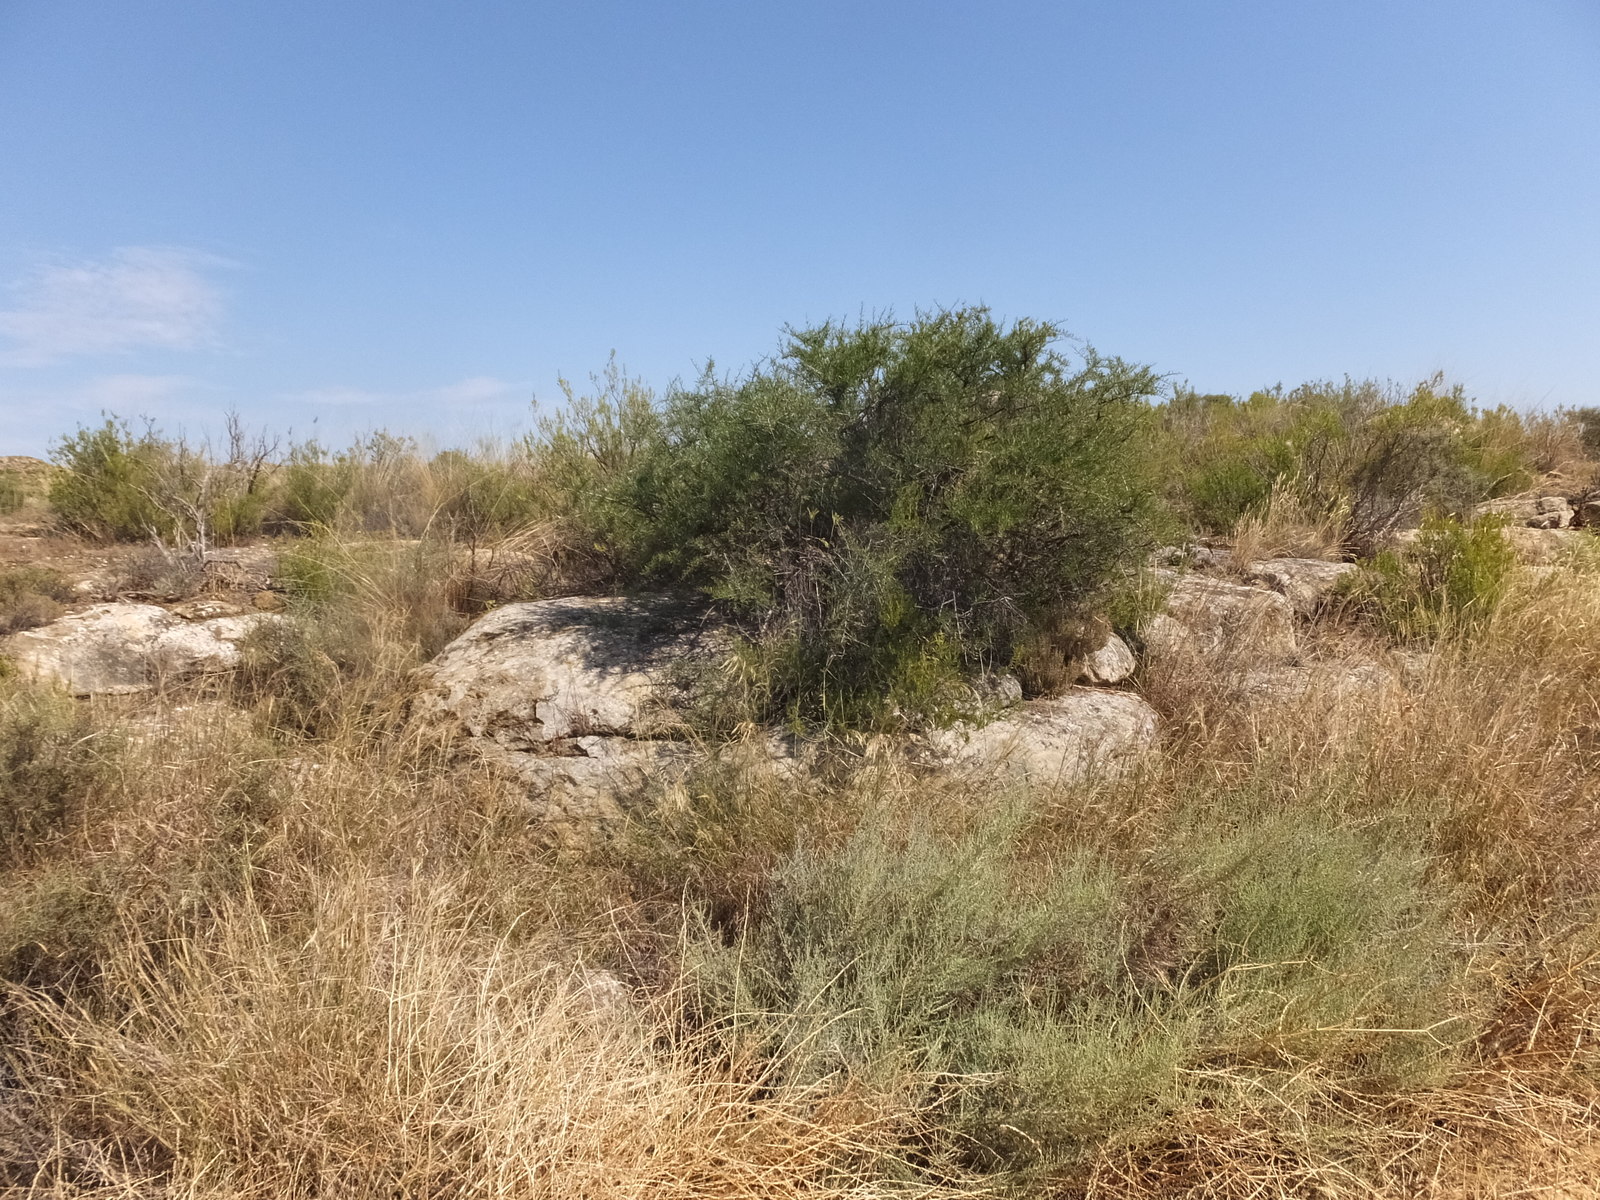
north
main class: Cropland
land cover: Barley
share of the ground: < 10 %
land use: Agriculture (excluding fallow land and kitchen gardens)
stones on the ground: < 10 %
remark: Harvested field
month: July
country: ES
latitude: 41.1695
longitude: -0.0598
